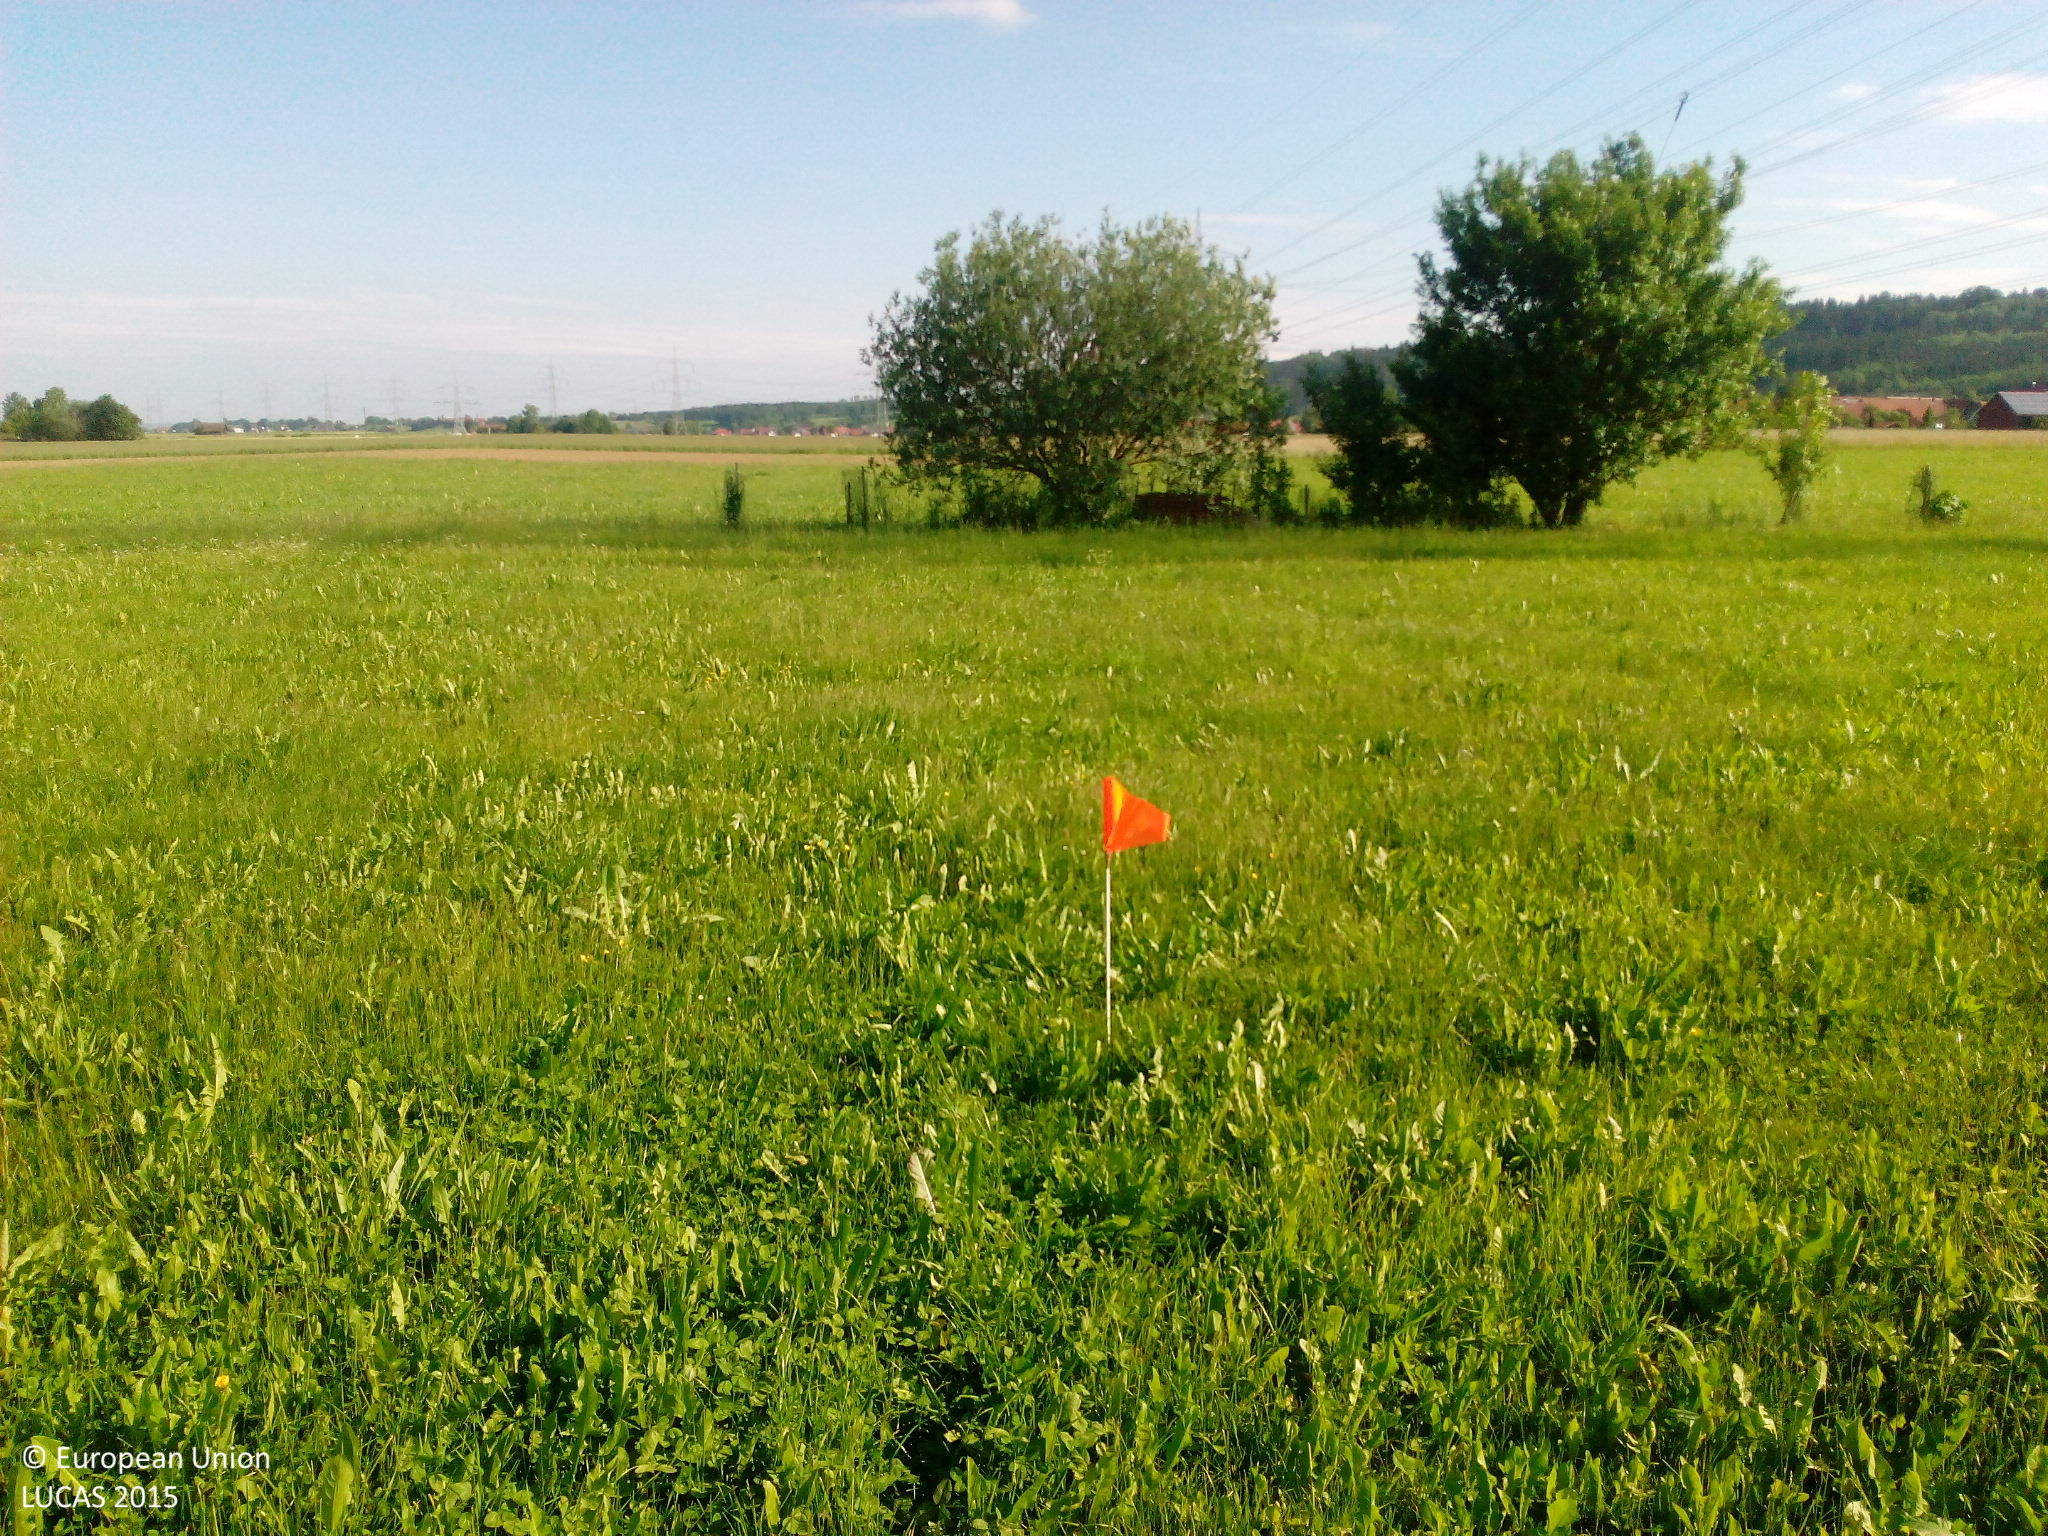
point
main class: Grassland
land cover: Grassland without tree/shrub cover
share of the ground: > 75 %
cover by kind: herbaceous plants 100 %
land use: Agriculture (excluding fallow land and kitchen gardens)
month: June
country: DE
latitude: 47.8993
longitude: 10.2540
